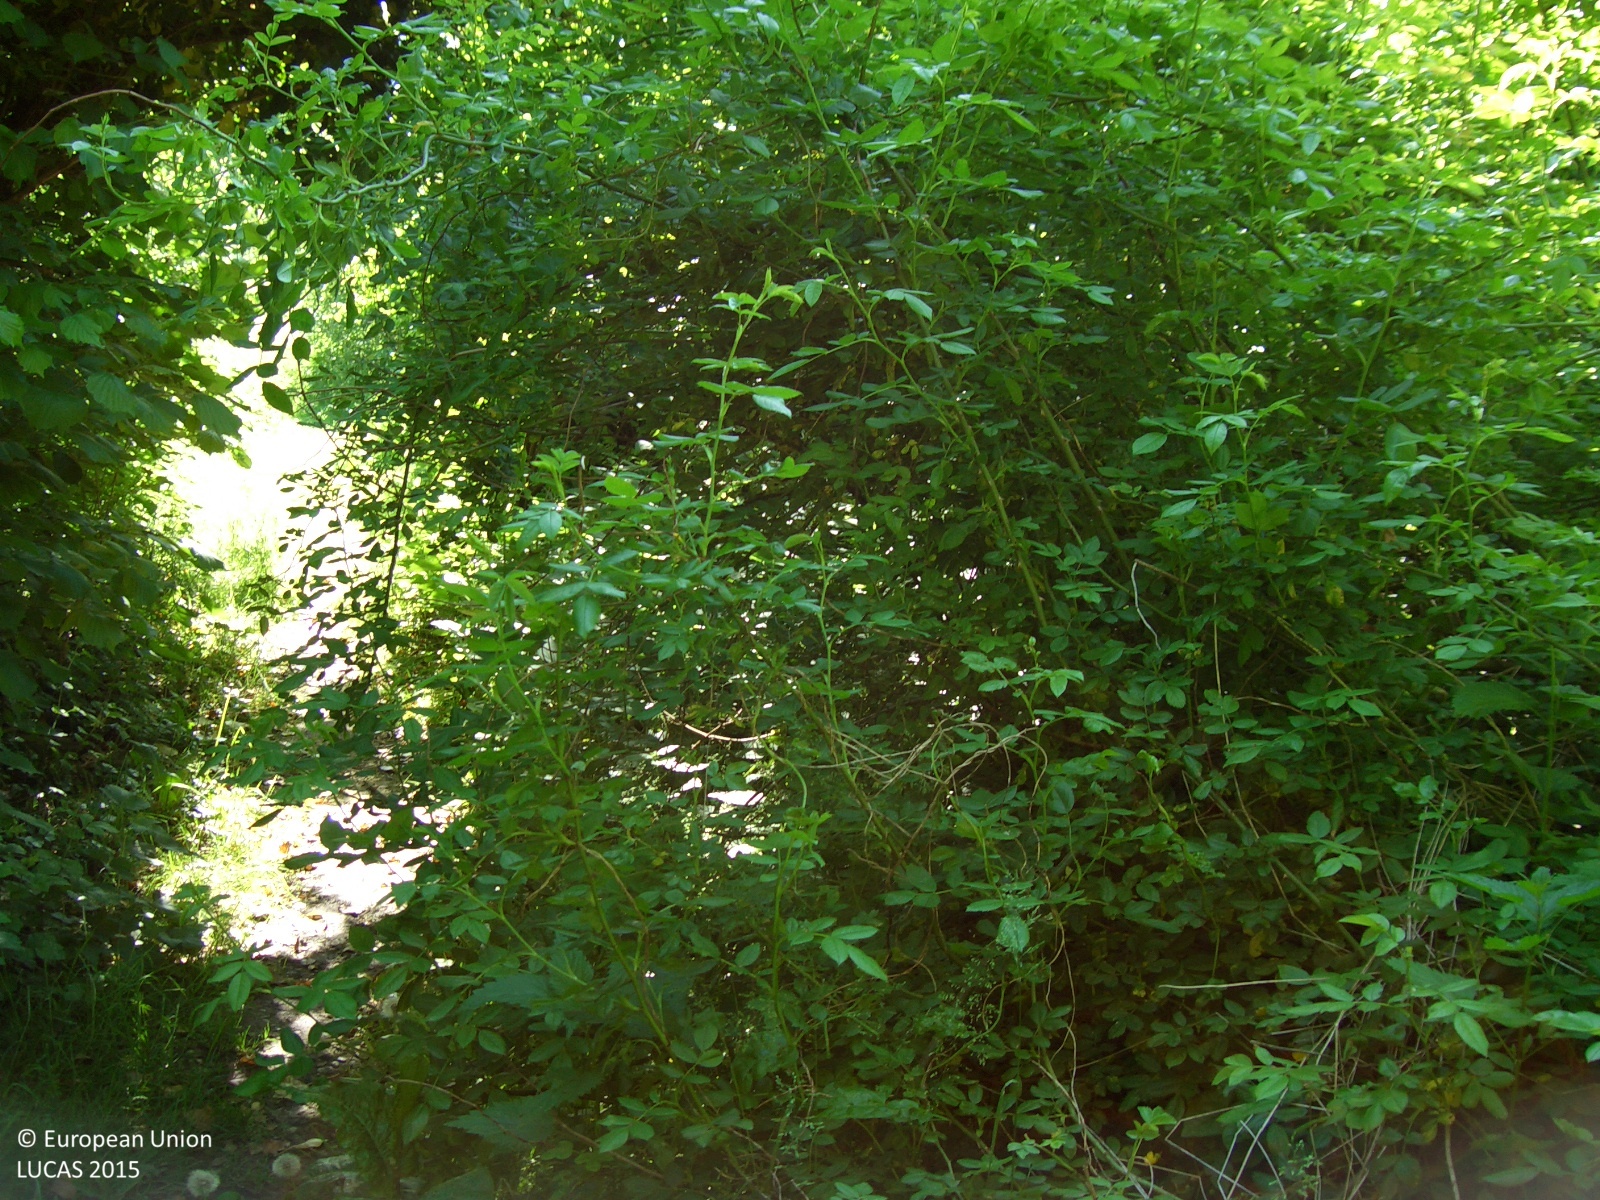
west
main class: Woodland
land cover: Other mixed woodland
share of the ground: > 75 %
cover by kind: broadleaved forest trees 50 %, coniferous forest trees 40 %, herbaceous plants 10 %
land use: Residential
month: June
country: DE
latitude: 50.8242
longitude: 6.2373
